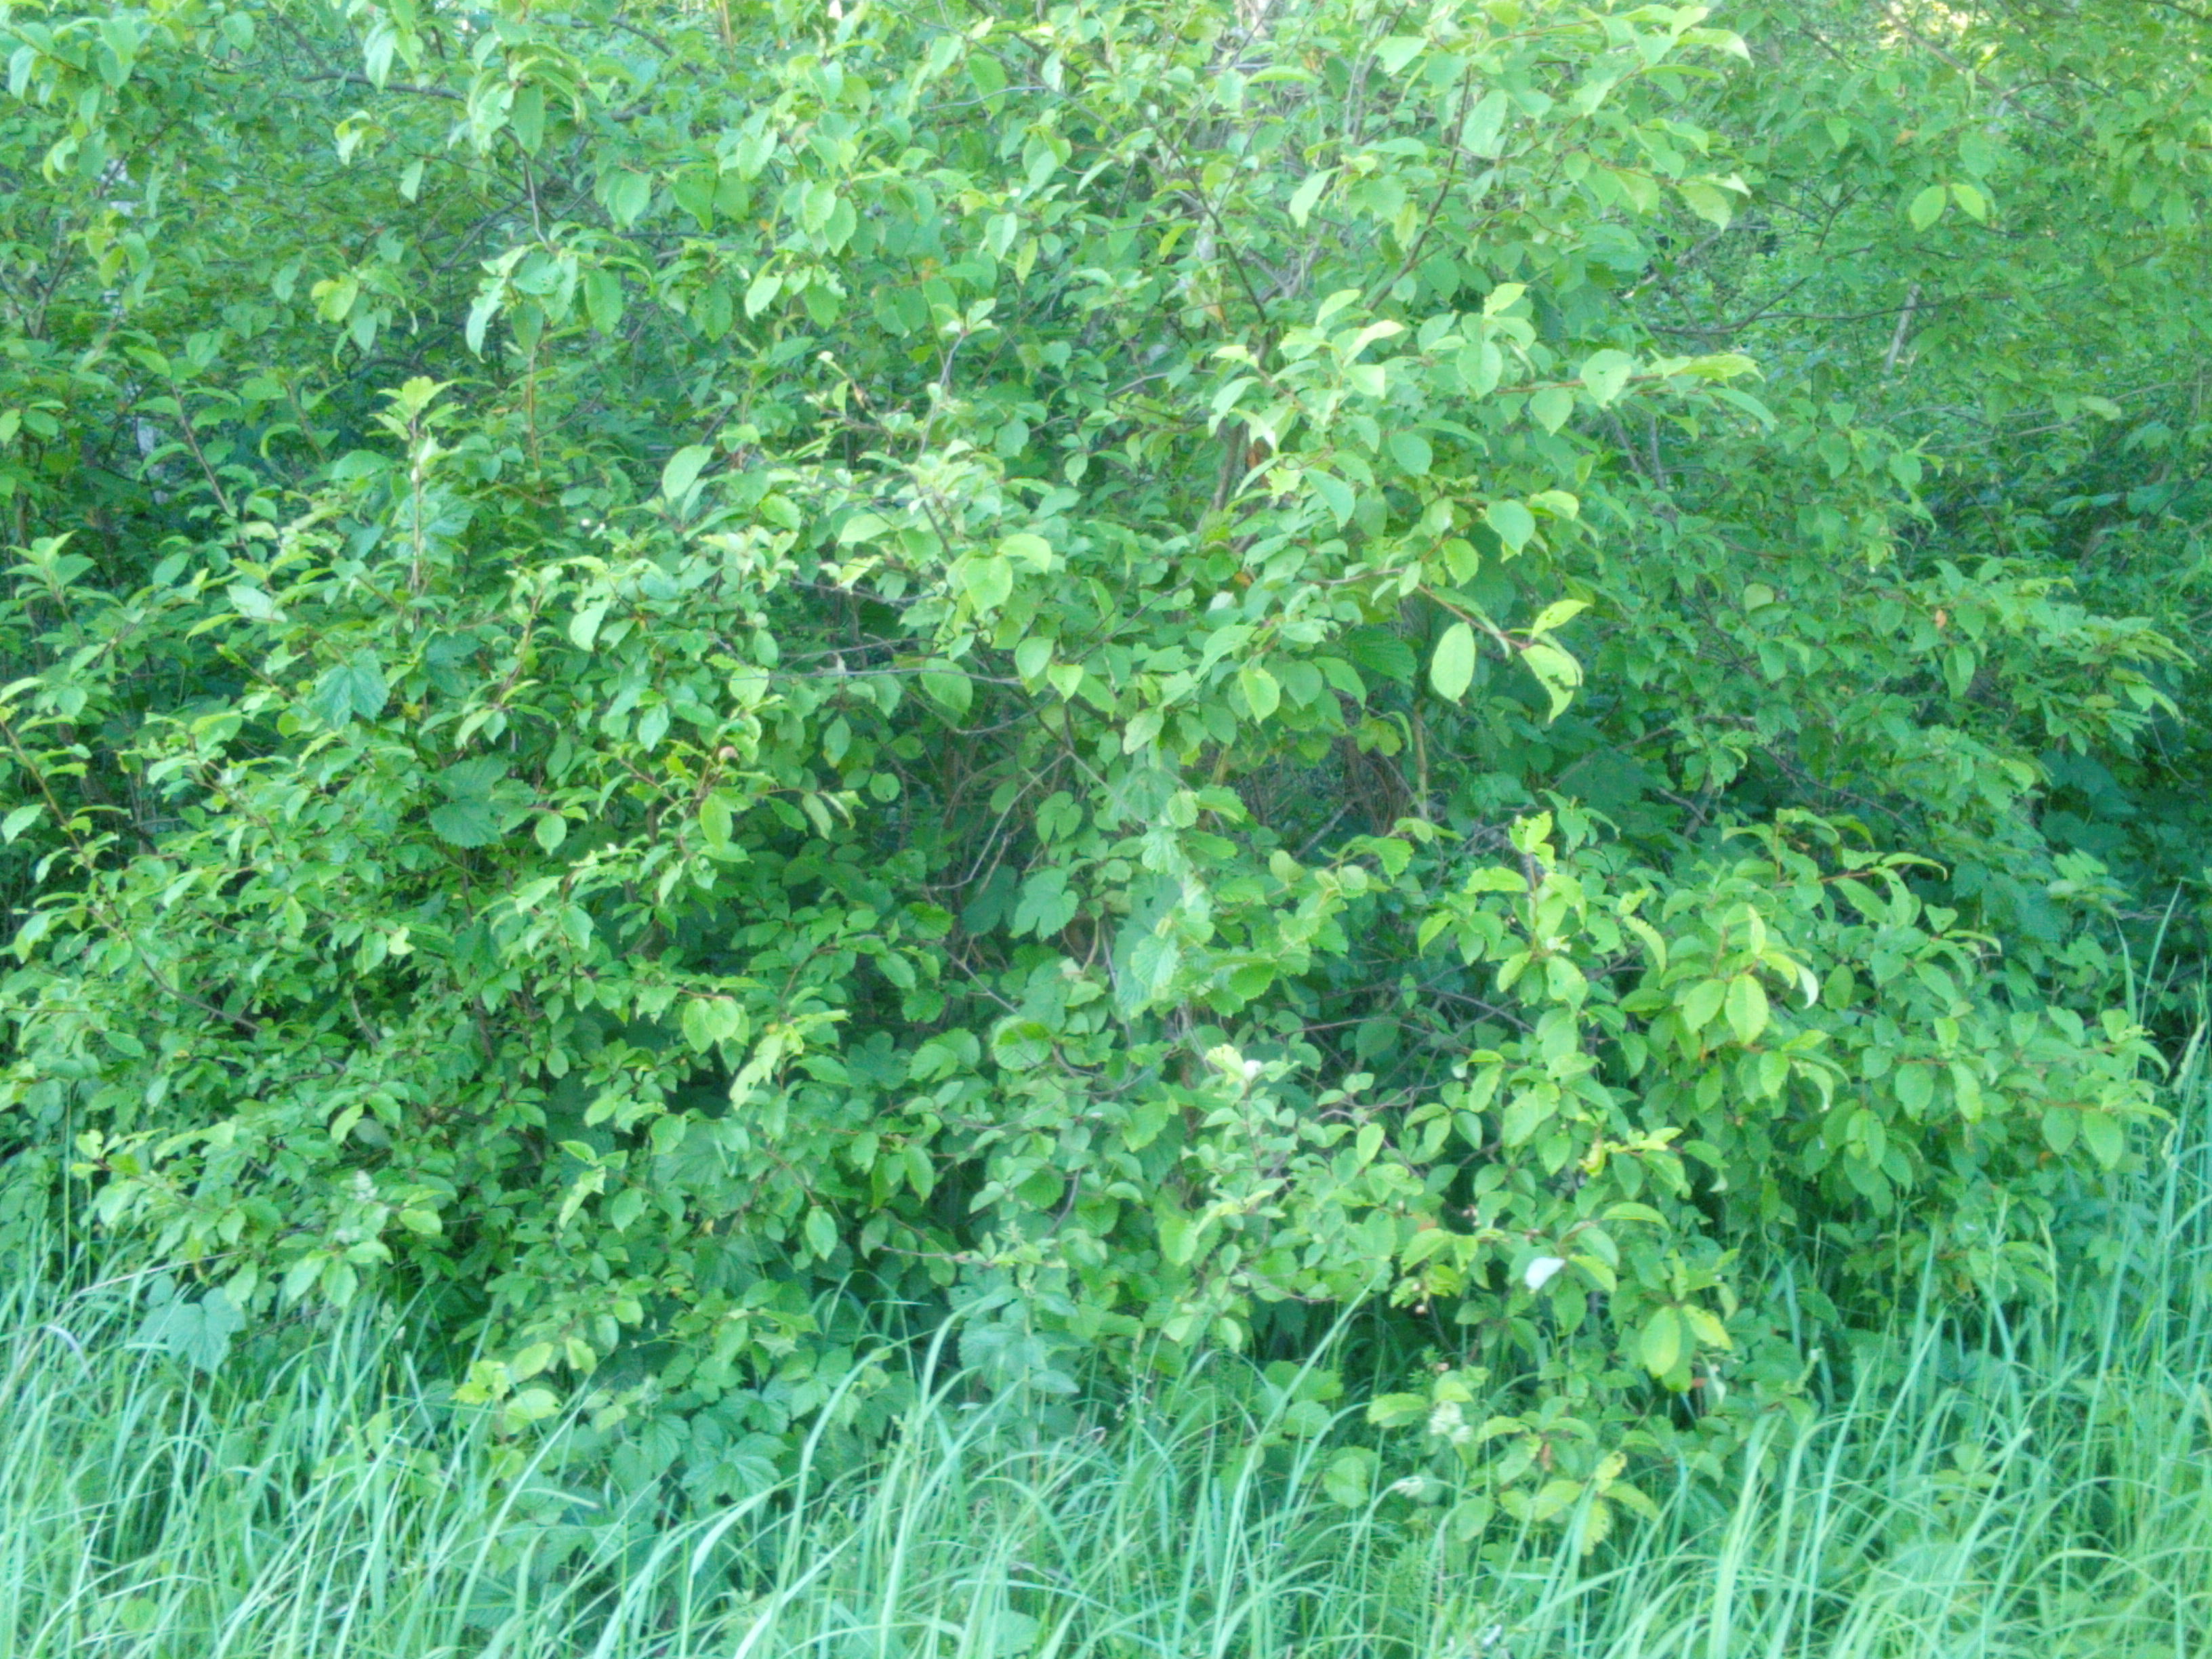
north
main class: Grassland
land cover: Grassland without tree/shrub cover
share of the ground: > 75 %
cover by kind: herbaceous plants 100 %
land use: Agriculture (excluding fallow land and kitchen gardens)
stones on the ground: < 10 %
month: June
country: LV
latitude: 56.6854
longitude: 22.1146
